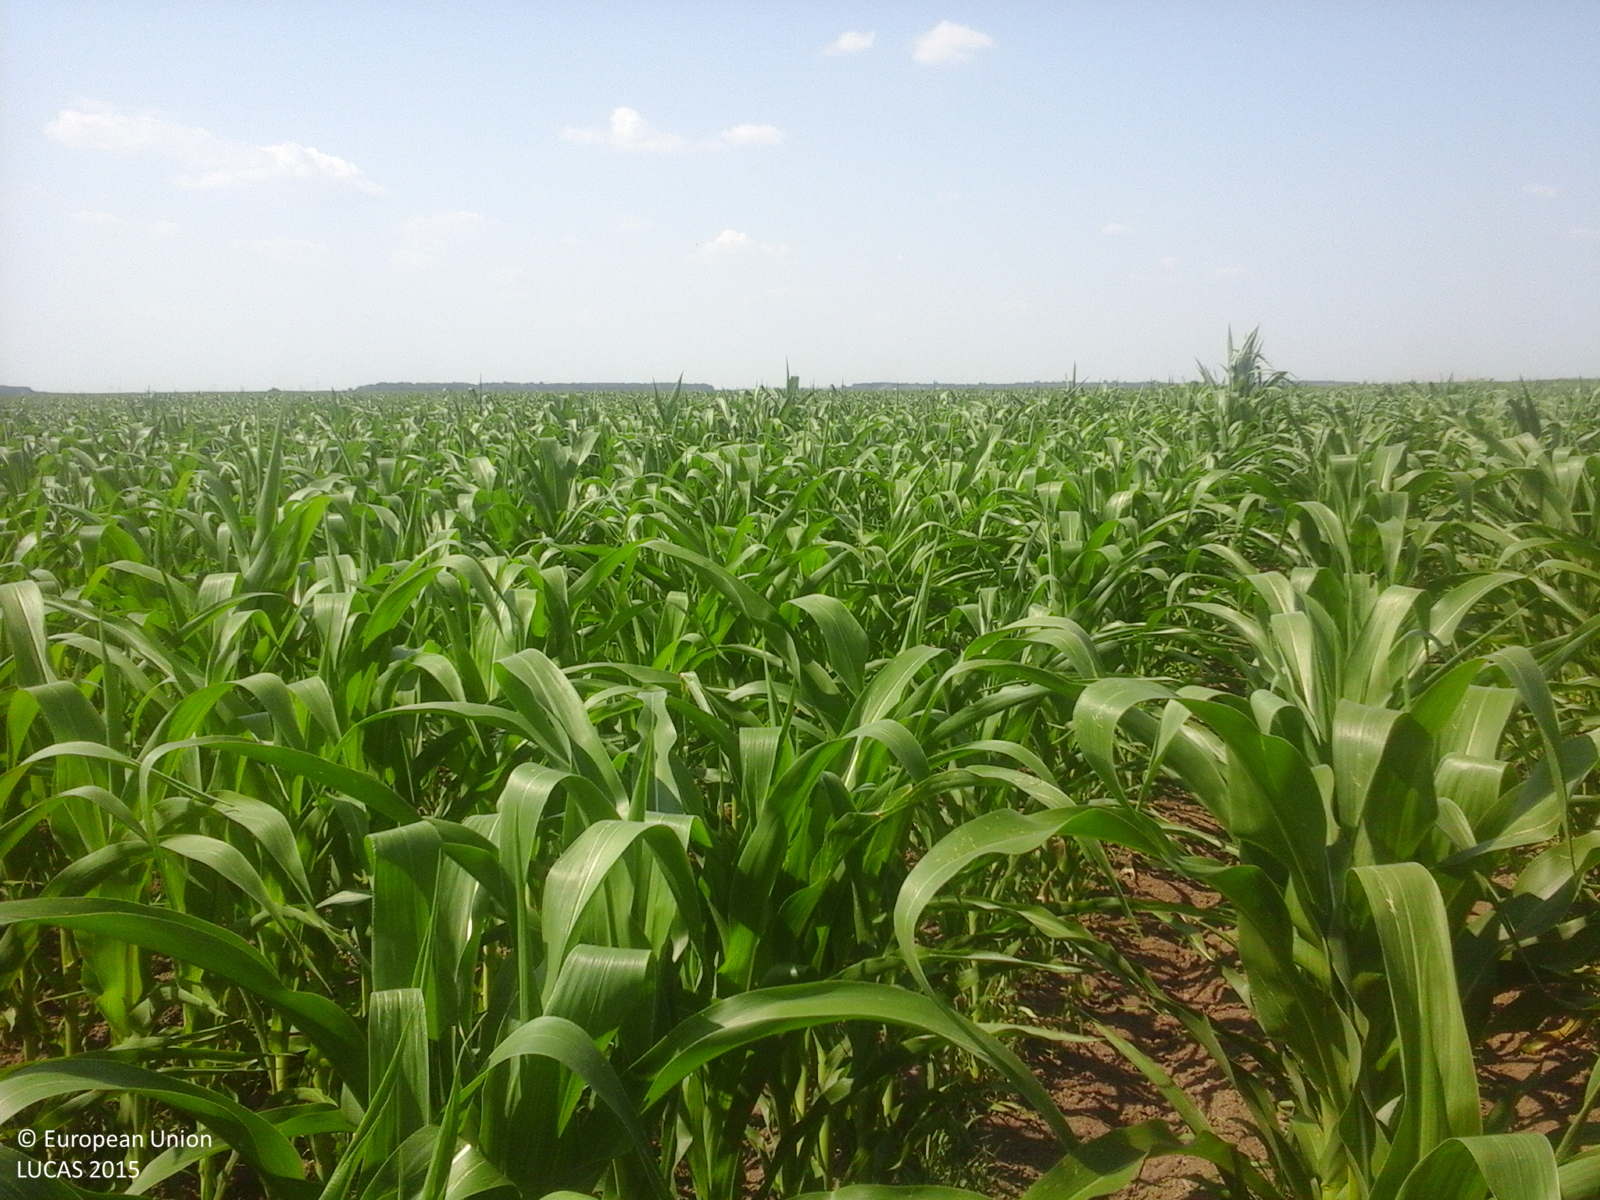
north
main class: Cropland
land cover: Maize
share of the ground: > 75 %
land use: Agriculture (excluding fallow land and kitchen gardens)
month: July
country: RO
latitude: 44.5787
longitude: 24.8257
